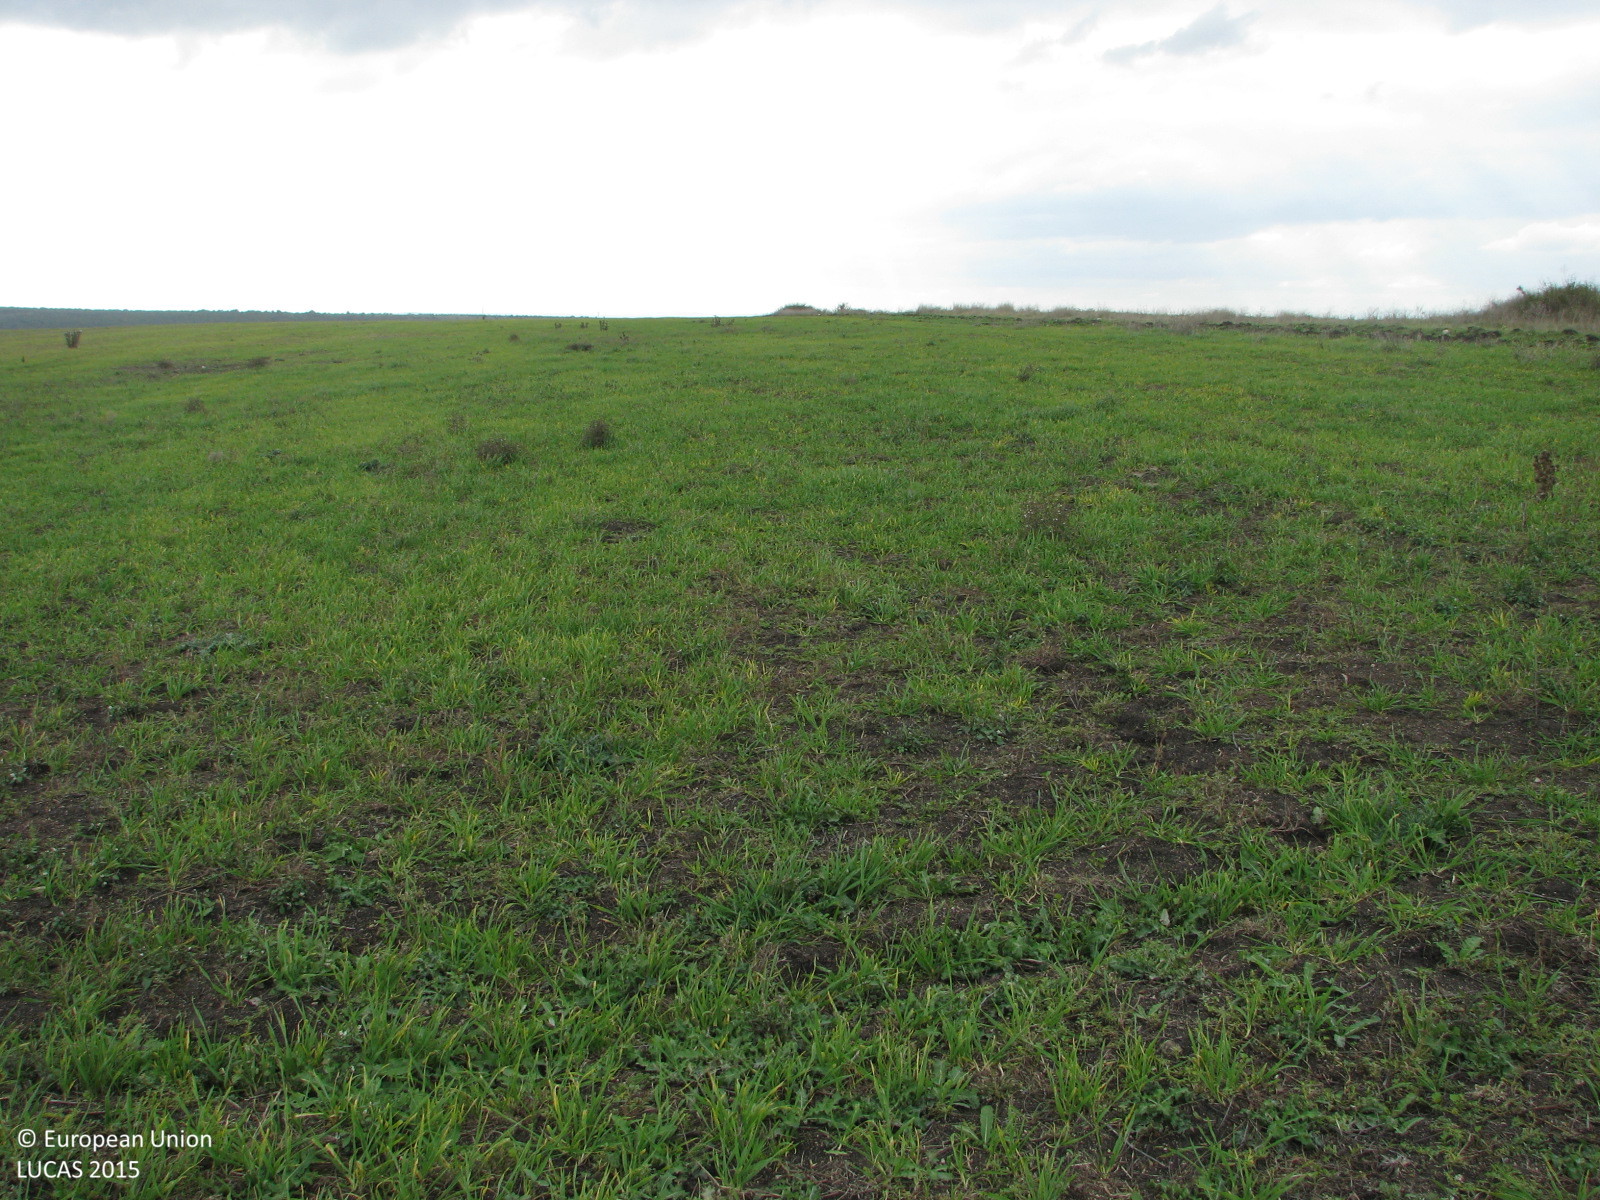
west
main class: Grassland
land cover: Spontaneously vegetated surfaces
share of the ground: > 75 %
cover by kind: herbaceous plants 80 %, unconsolidated bare surface 20 %
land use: Agriculture (excluding fallow land and kitchen gardens)
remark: Harvested field
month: October
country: BG
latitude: 42.2224
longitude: 26.7530
